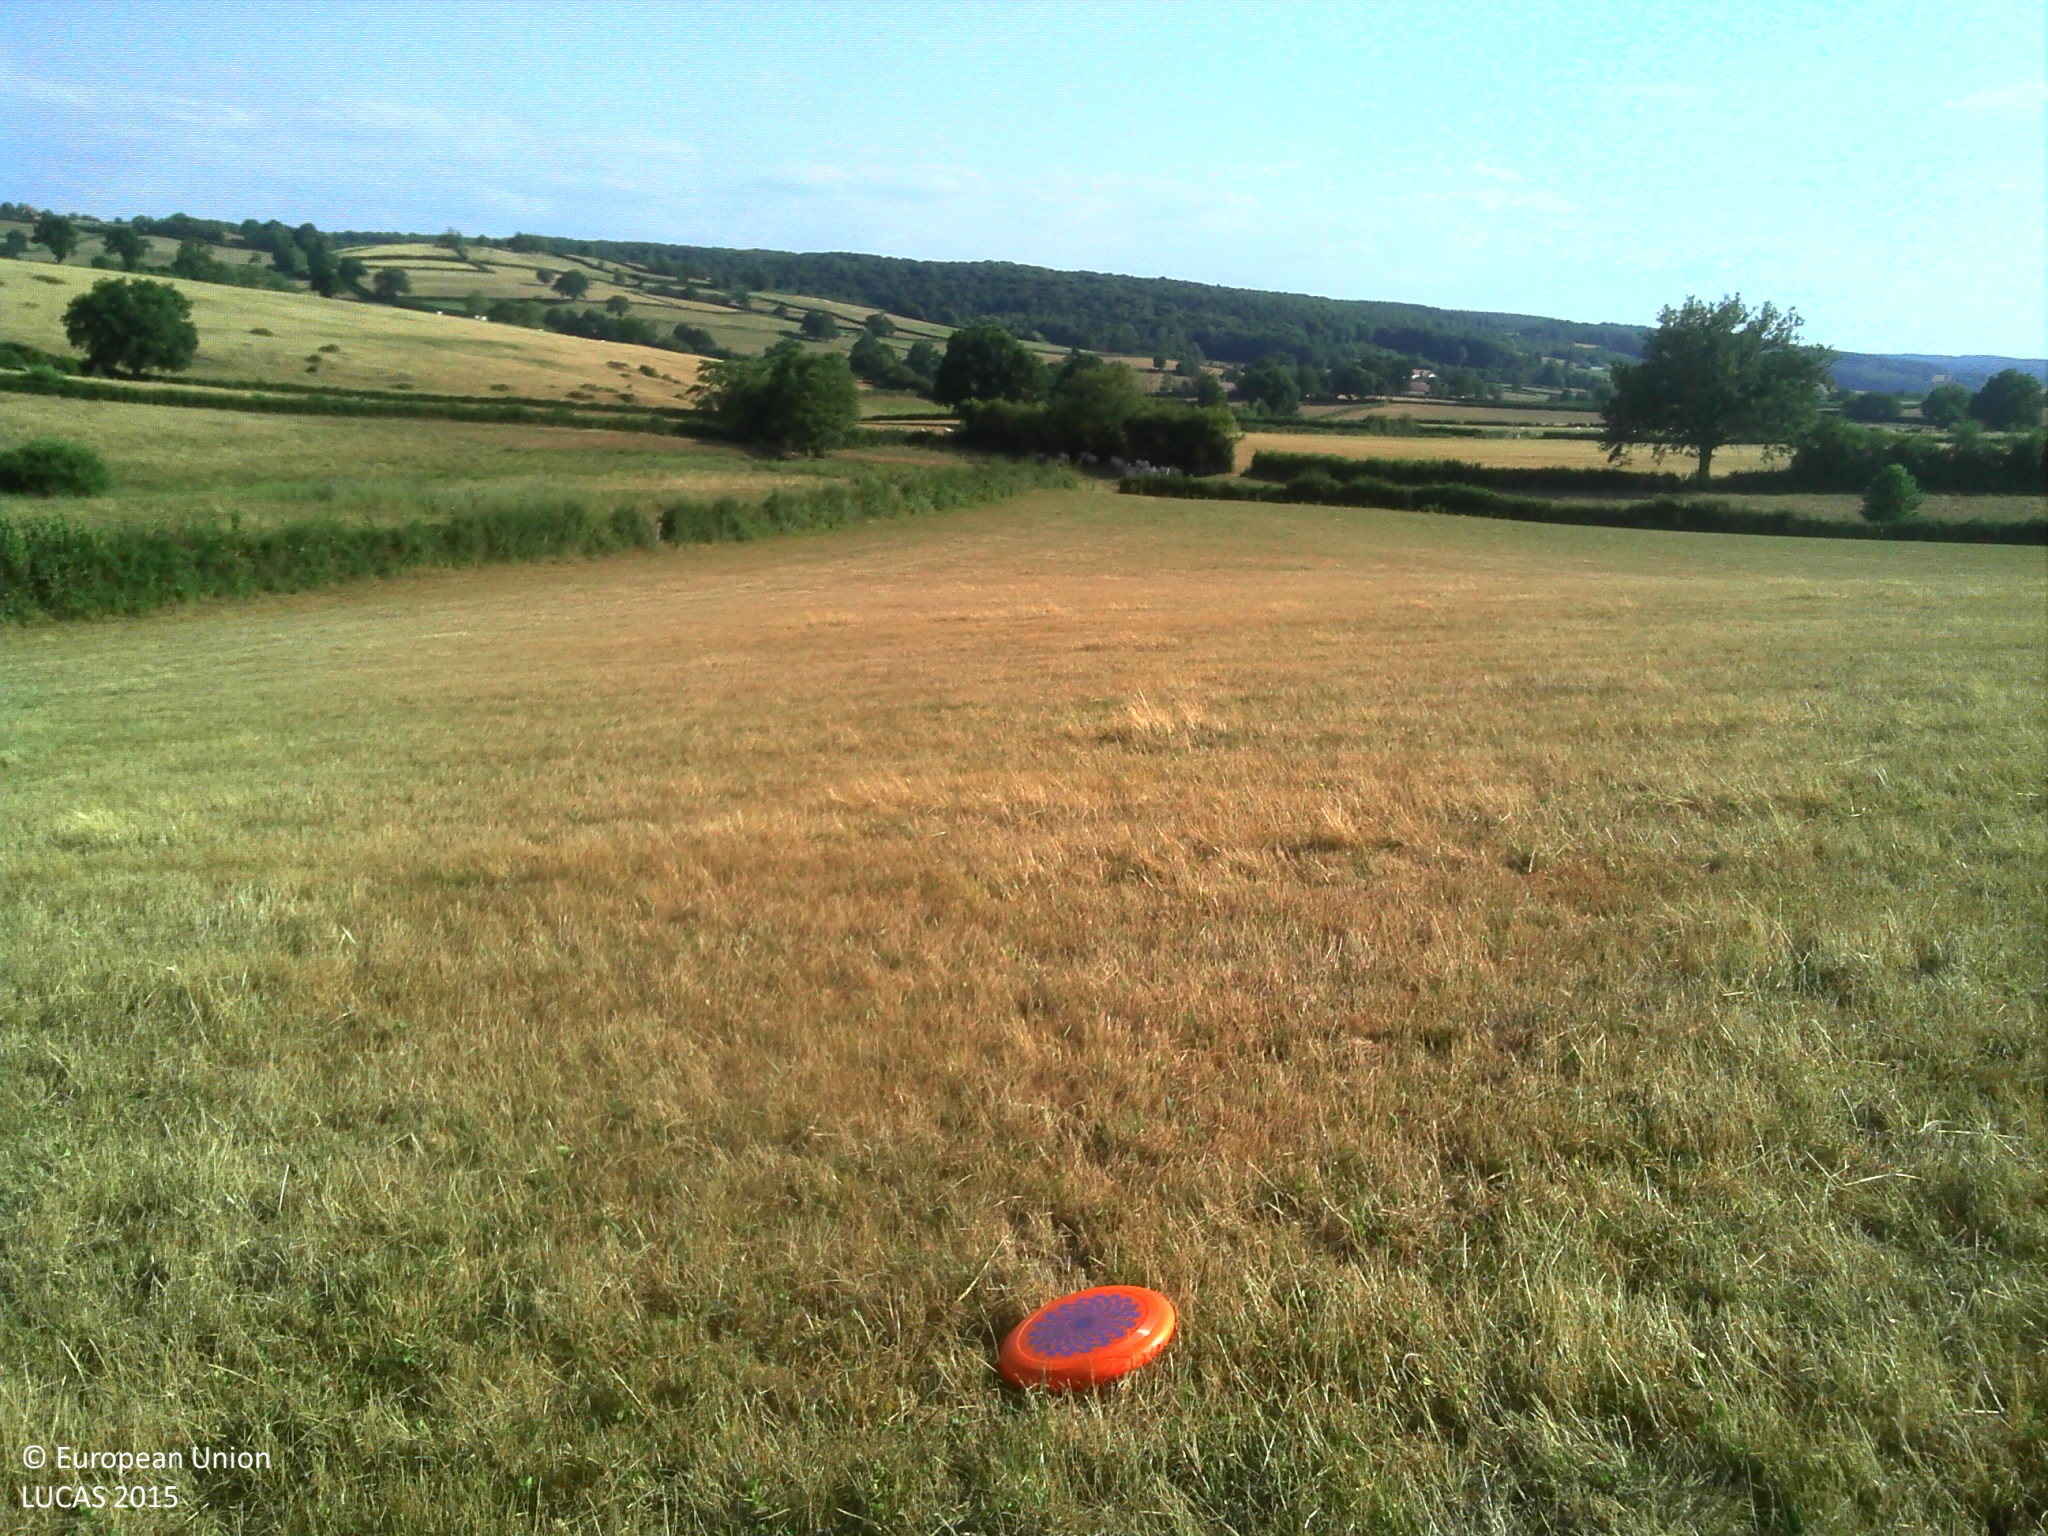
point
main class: Grassland
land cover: Grassland without tree/shrub cover
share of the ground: > 75 %
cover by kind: herbaceous plants 100 %
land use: Agriculture (excluding fallow land and kitchen gardens)
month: July
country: FR
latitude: 46.6183
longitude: 4.3725
